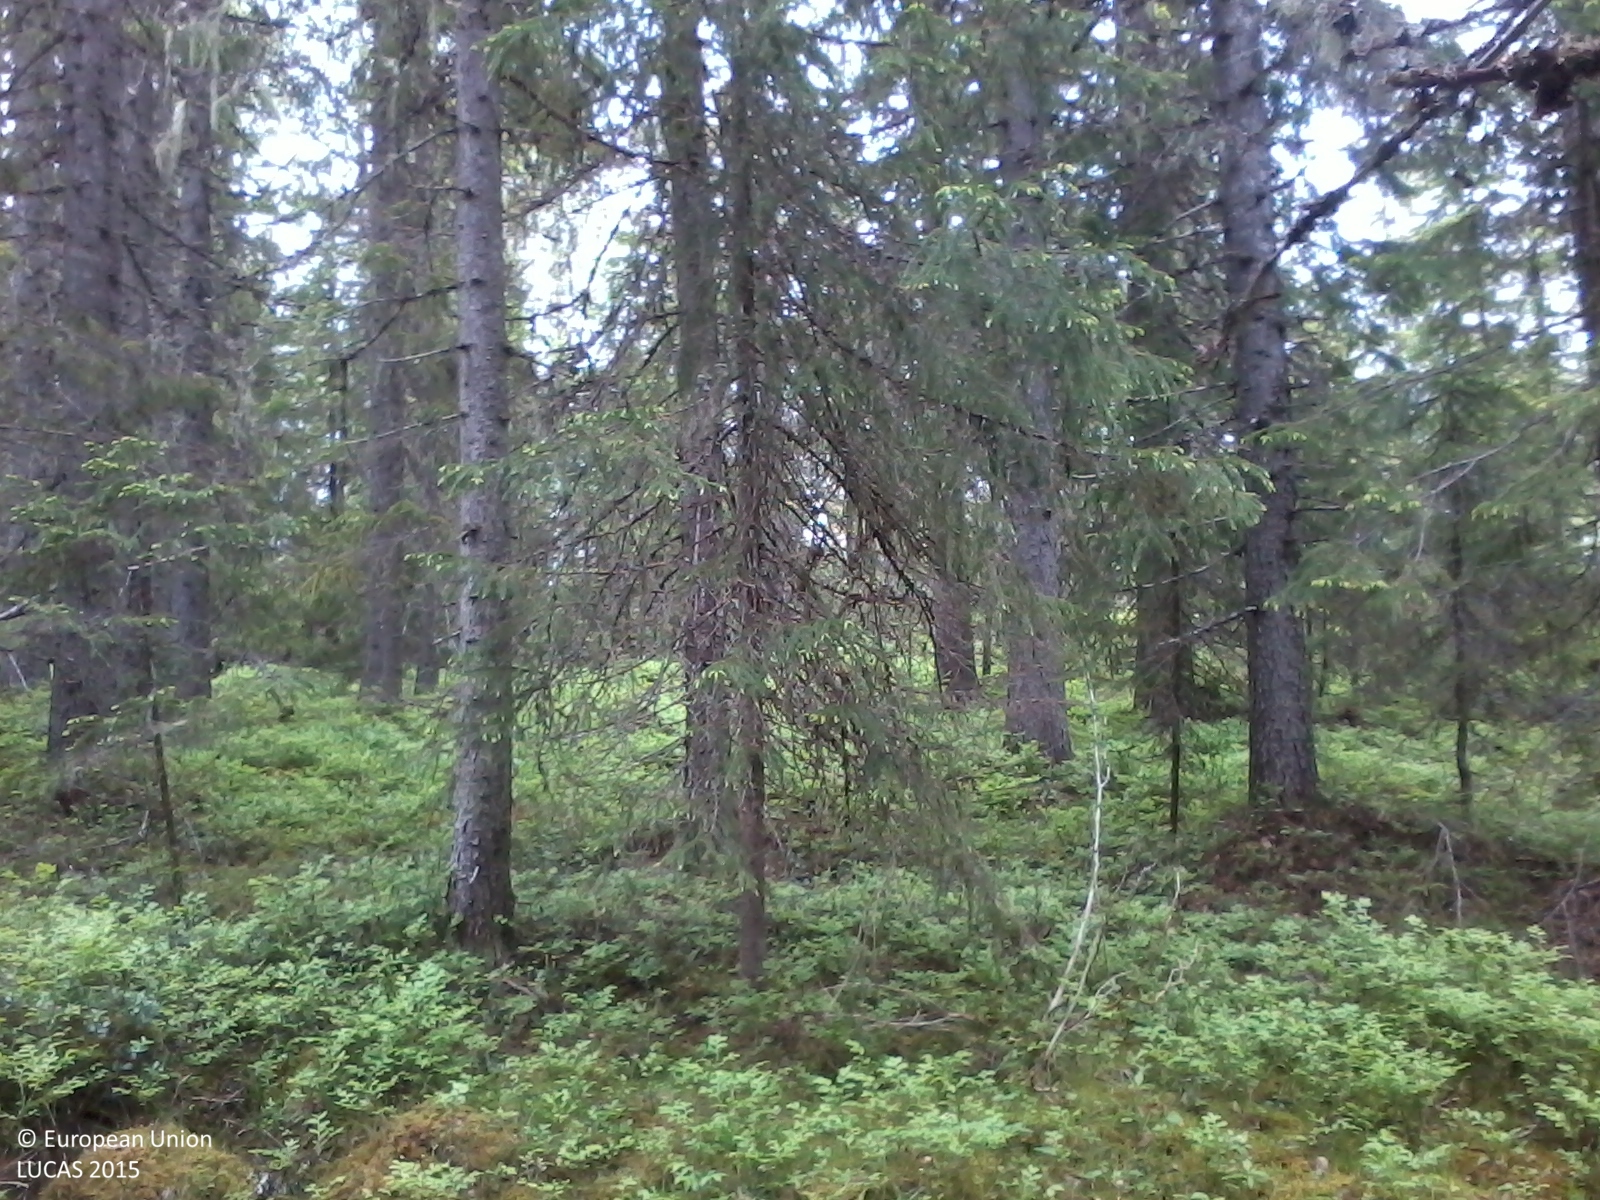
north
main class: Woodland
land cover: Spruce dominated coniferous woodland
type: boreal forest
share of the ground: 50 - 75 %
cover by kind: coniferous forest trees 60 %, shrubs 35 %, broadleaved forest trees 5 %
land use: Forestry
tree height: > 5 m
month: June
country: SE
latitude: 63.4888
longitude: 17.9867
